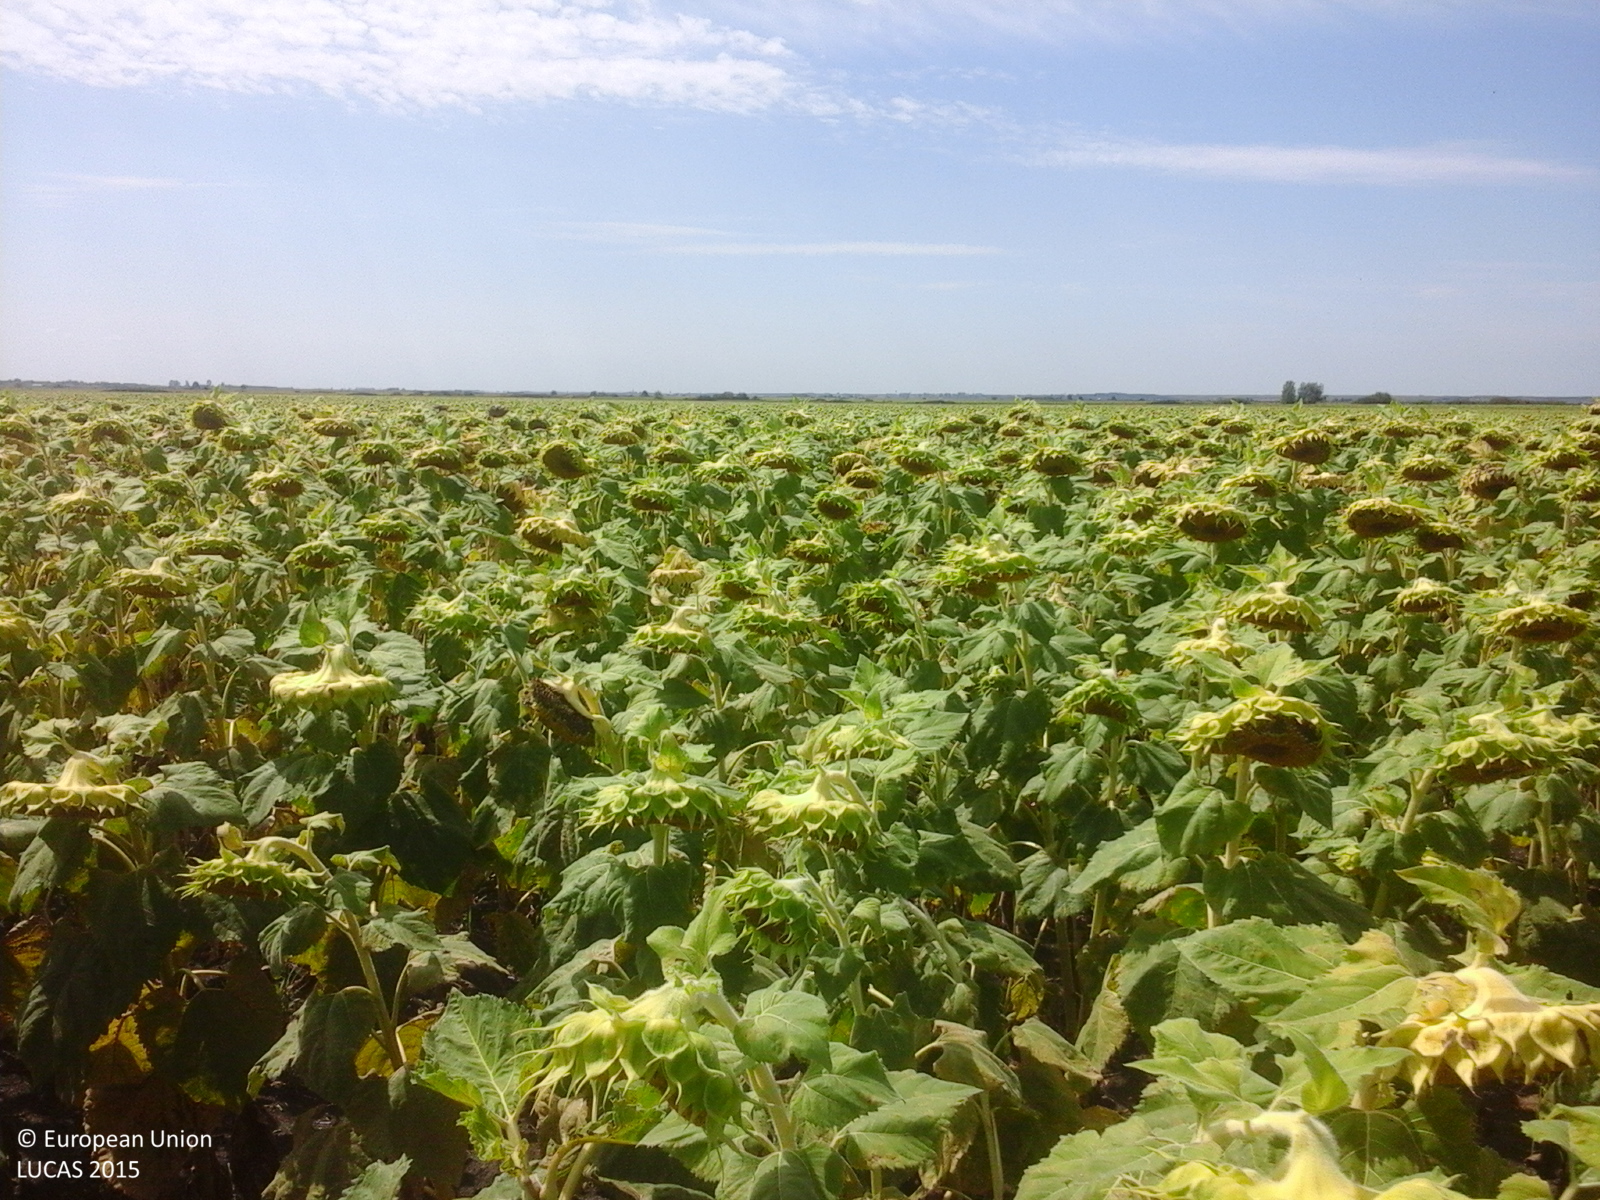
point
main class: Cropland
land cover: Sunflower
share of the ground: > 75 %
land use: Agriculture (excluding fallow land and kitchen gardens)
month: August
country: RO
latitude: 45.3039
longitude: 21.3932
